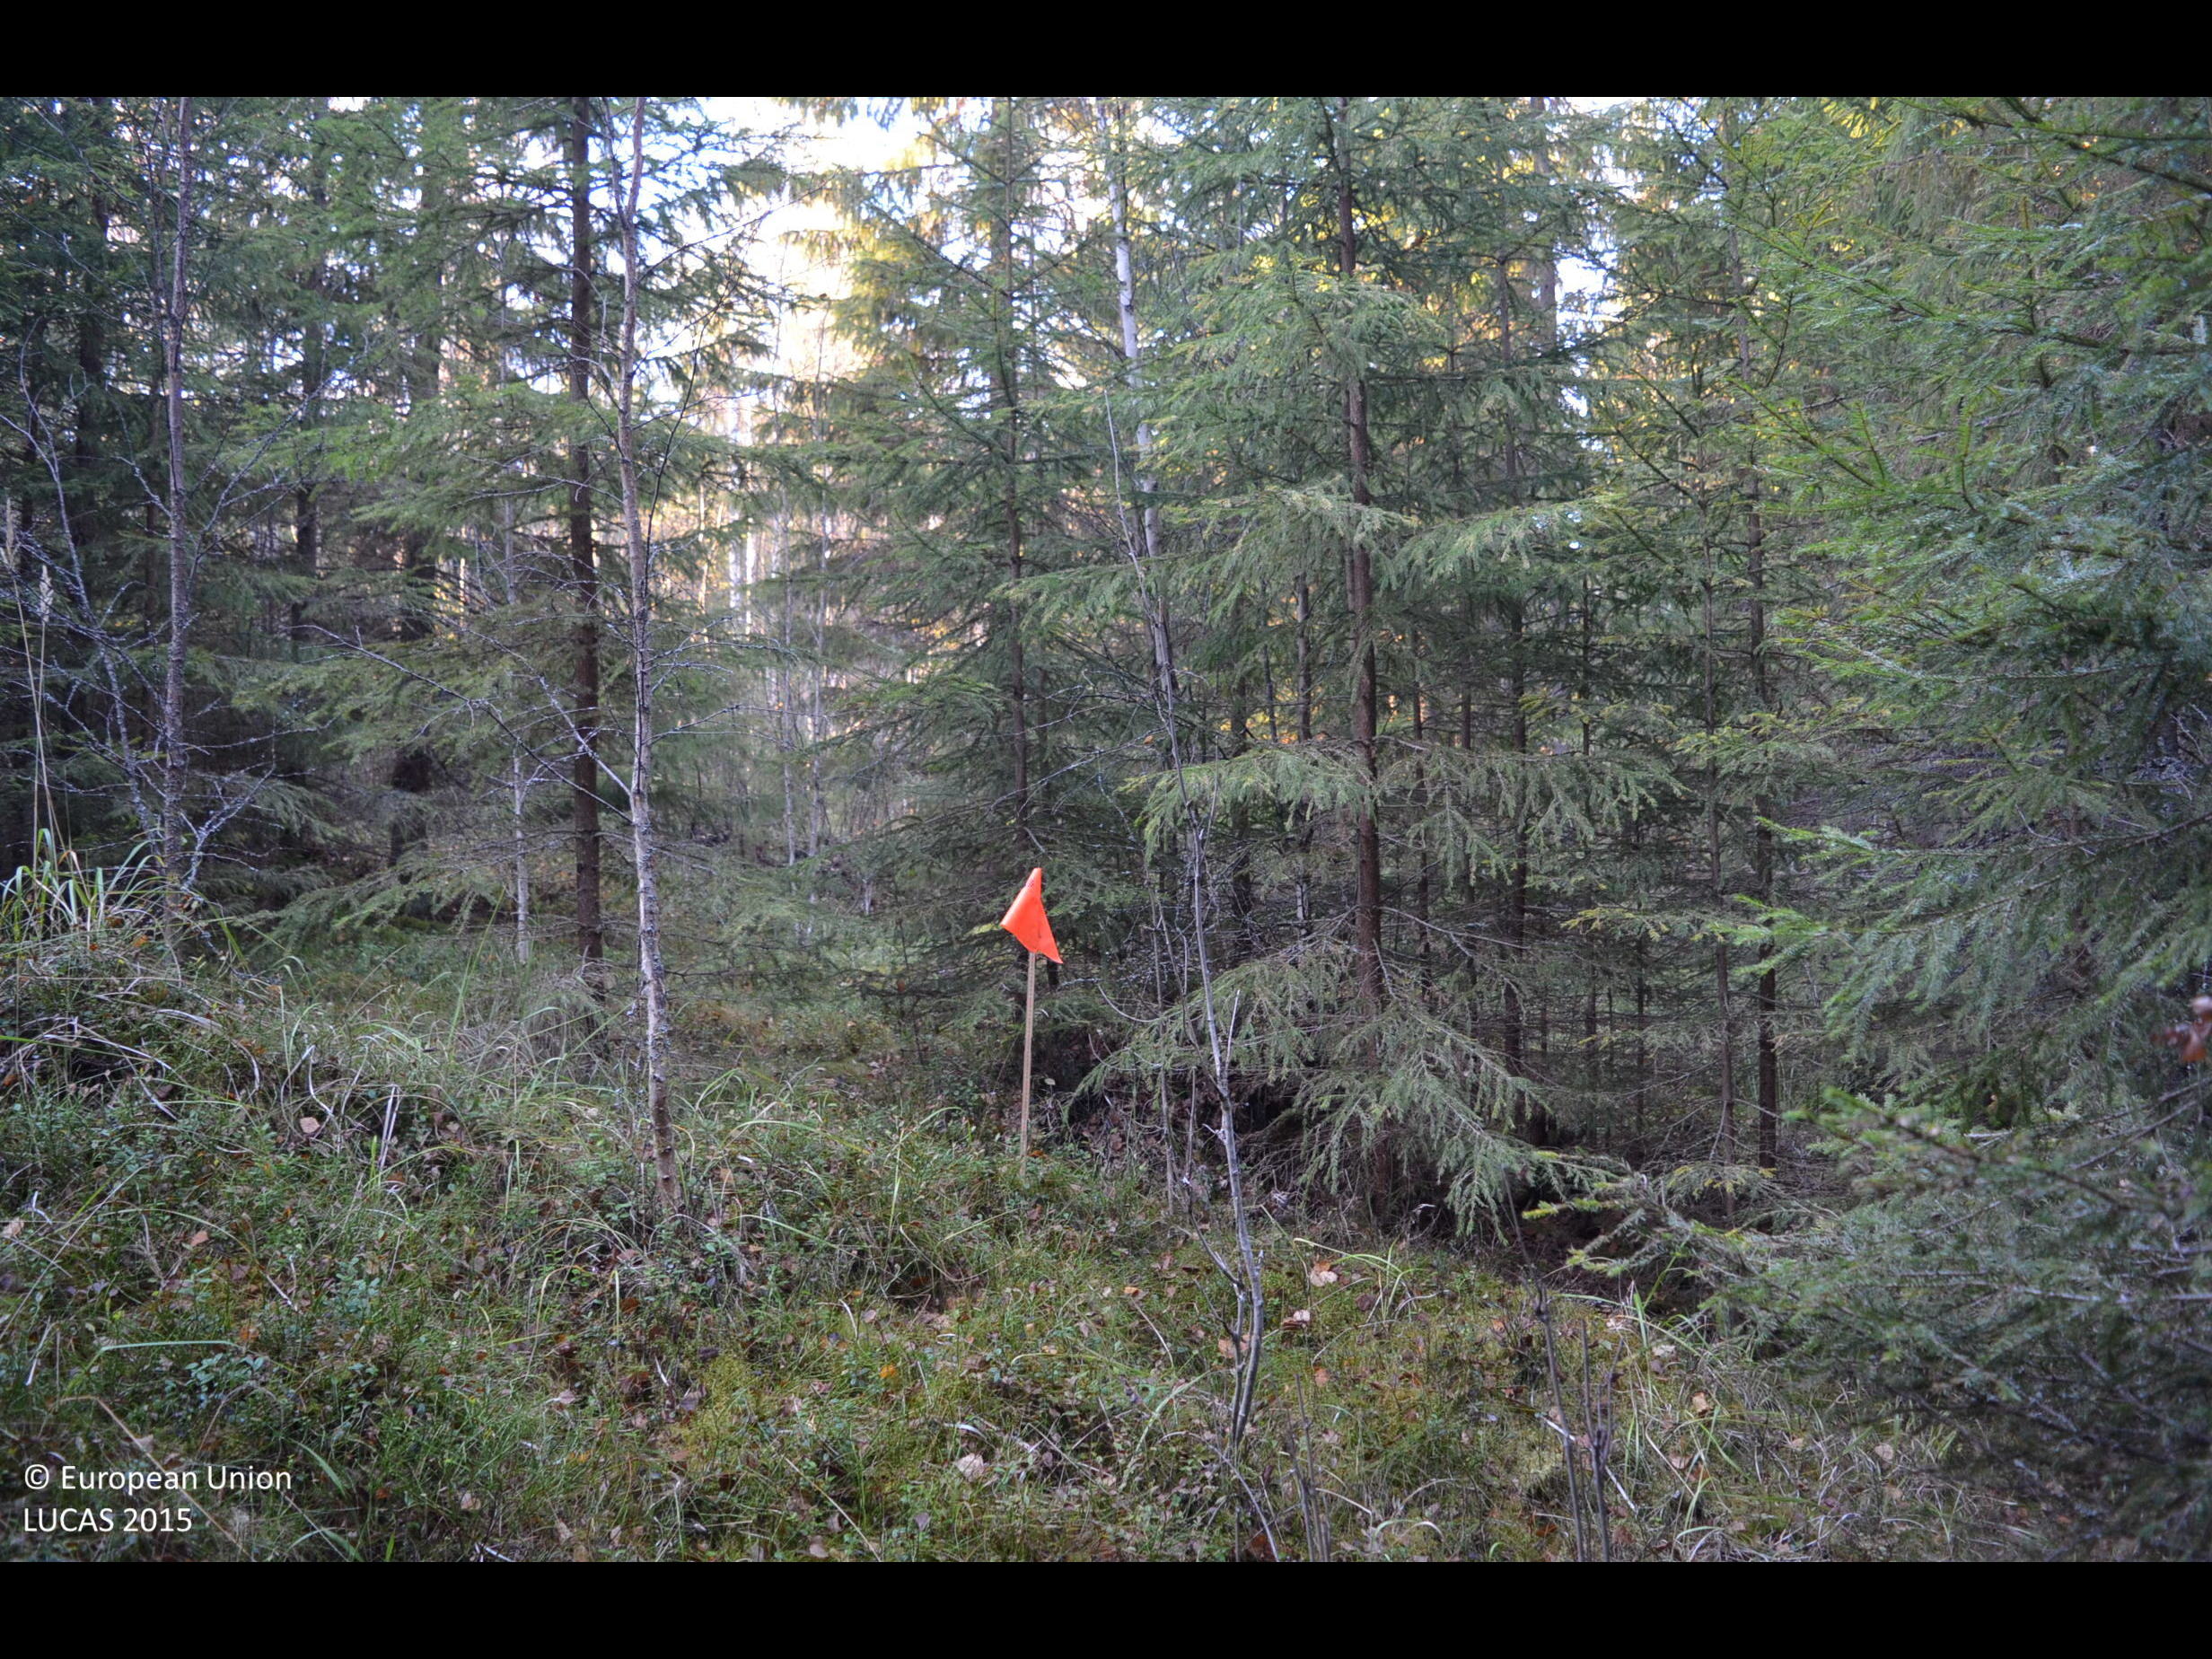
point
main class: Woodland
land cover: Spruce dominated coniferous woodland
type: boreal forest
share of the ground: > 75 %
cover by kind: coniferous forest trees 70 %, shrubs 15 %, broadleaved forest trees 10 %, lichens and mosses 5 %
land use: Forestry
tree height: > 5 m
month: October
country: FI
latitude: 61.7829
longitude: 23.8670
